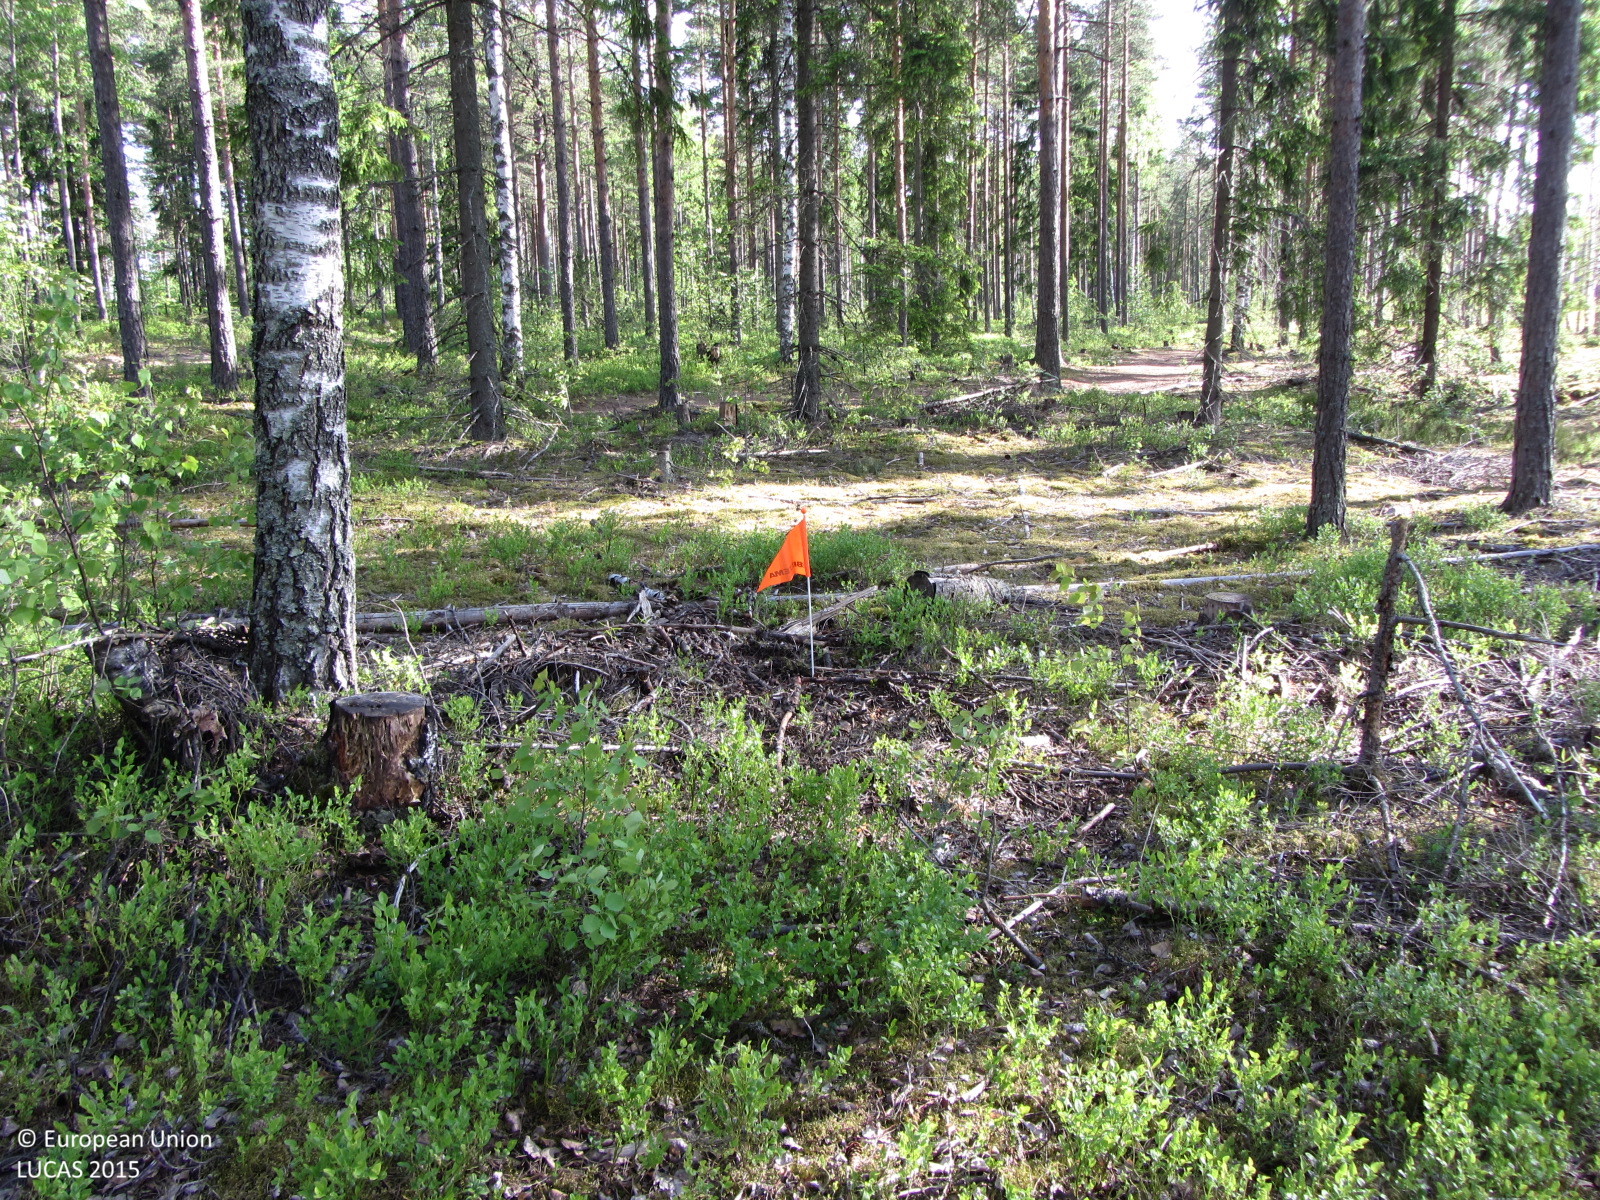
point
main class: Woodland
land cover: Other mixed woodland
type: boreal forest
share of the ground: > 75 %
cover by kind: coniferous forest trees 55 %, broadleaved forest trees 30 %, shrubs 5 %, lichens and mosses 5 %, unconsolidated bare surface 5 %
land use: Forestry
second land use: Amenities, museums, leisure
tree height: > 5 m
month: June
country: FI
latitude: 60.3288
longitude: 24.2833
